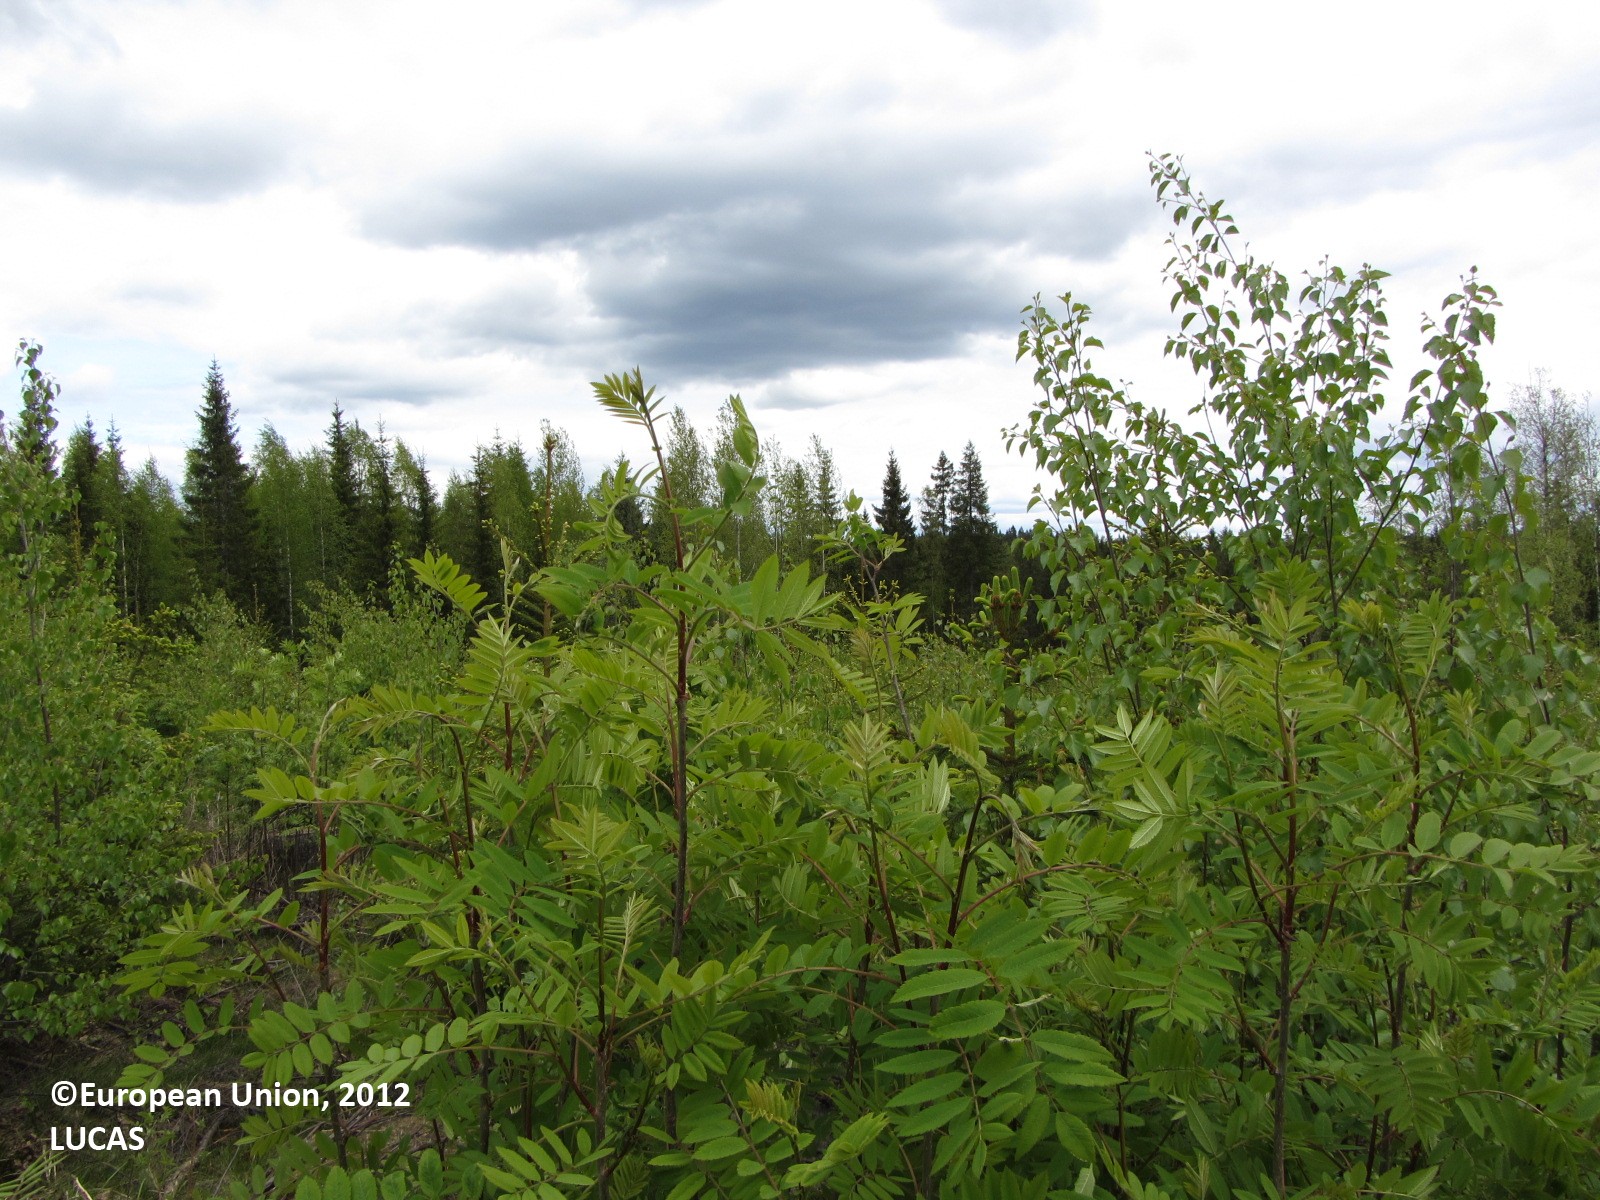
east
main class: Woodland
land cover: Spruce dominated mixed woodland
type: boreal forest
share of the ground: > 75 %
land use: Forestry
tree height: < 5 m
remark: Nursery
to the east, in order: Spruce dominated mixed woodland; Grassland with sparse tree/shrub cover; Spruce dominated mixed woodland; Ditches and canals; Grassland with sparse tree/shrub cover; Spruce dominated mixed woodland; Ditches and canals; Spruce dominated mixed woodland; Shrubland without tree cover; Spruce dominated mixed woodland; Ditches and canals; Spruce dominated mixed woodland; Spruce dominated coniferous woodland
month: May
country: FI
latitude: 62.2360
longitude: 25.4102
